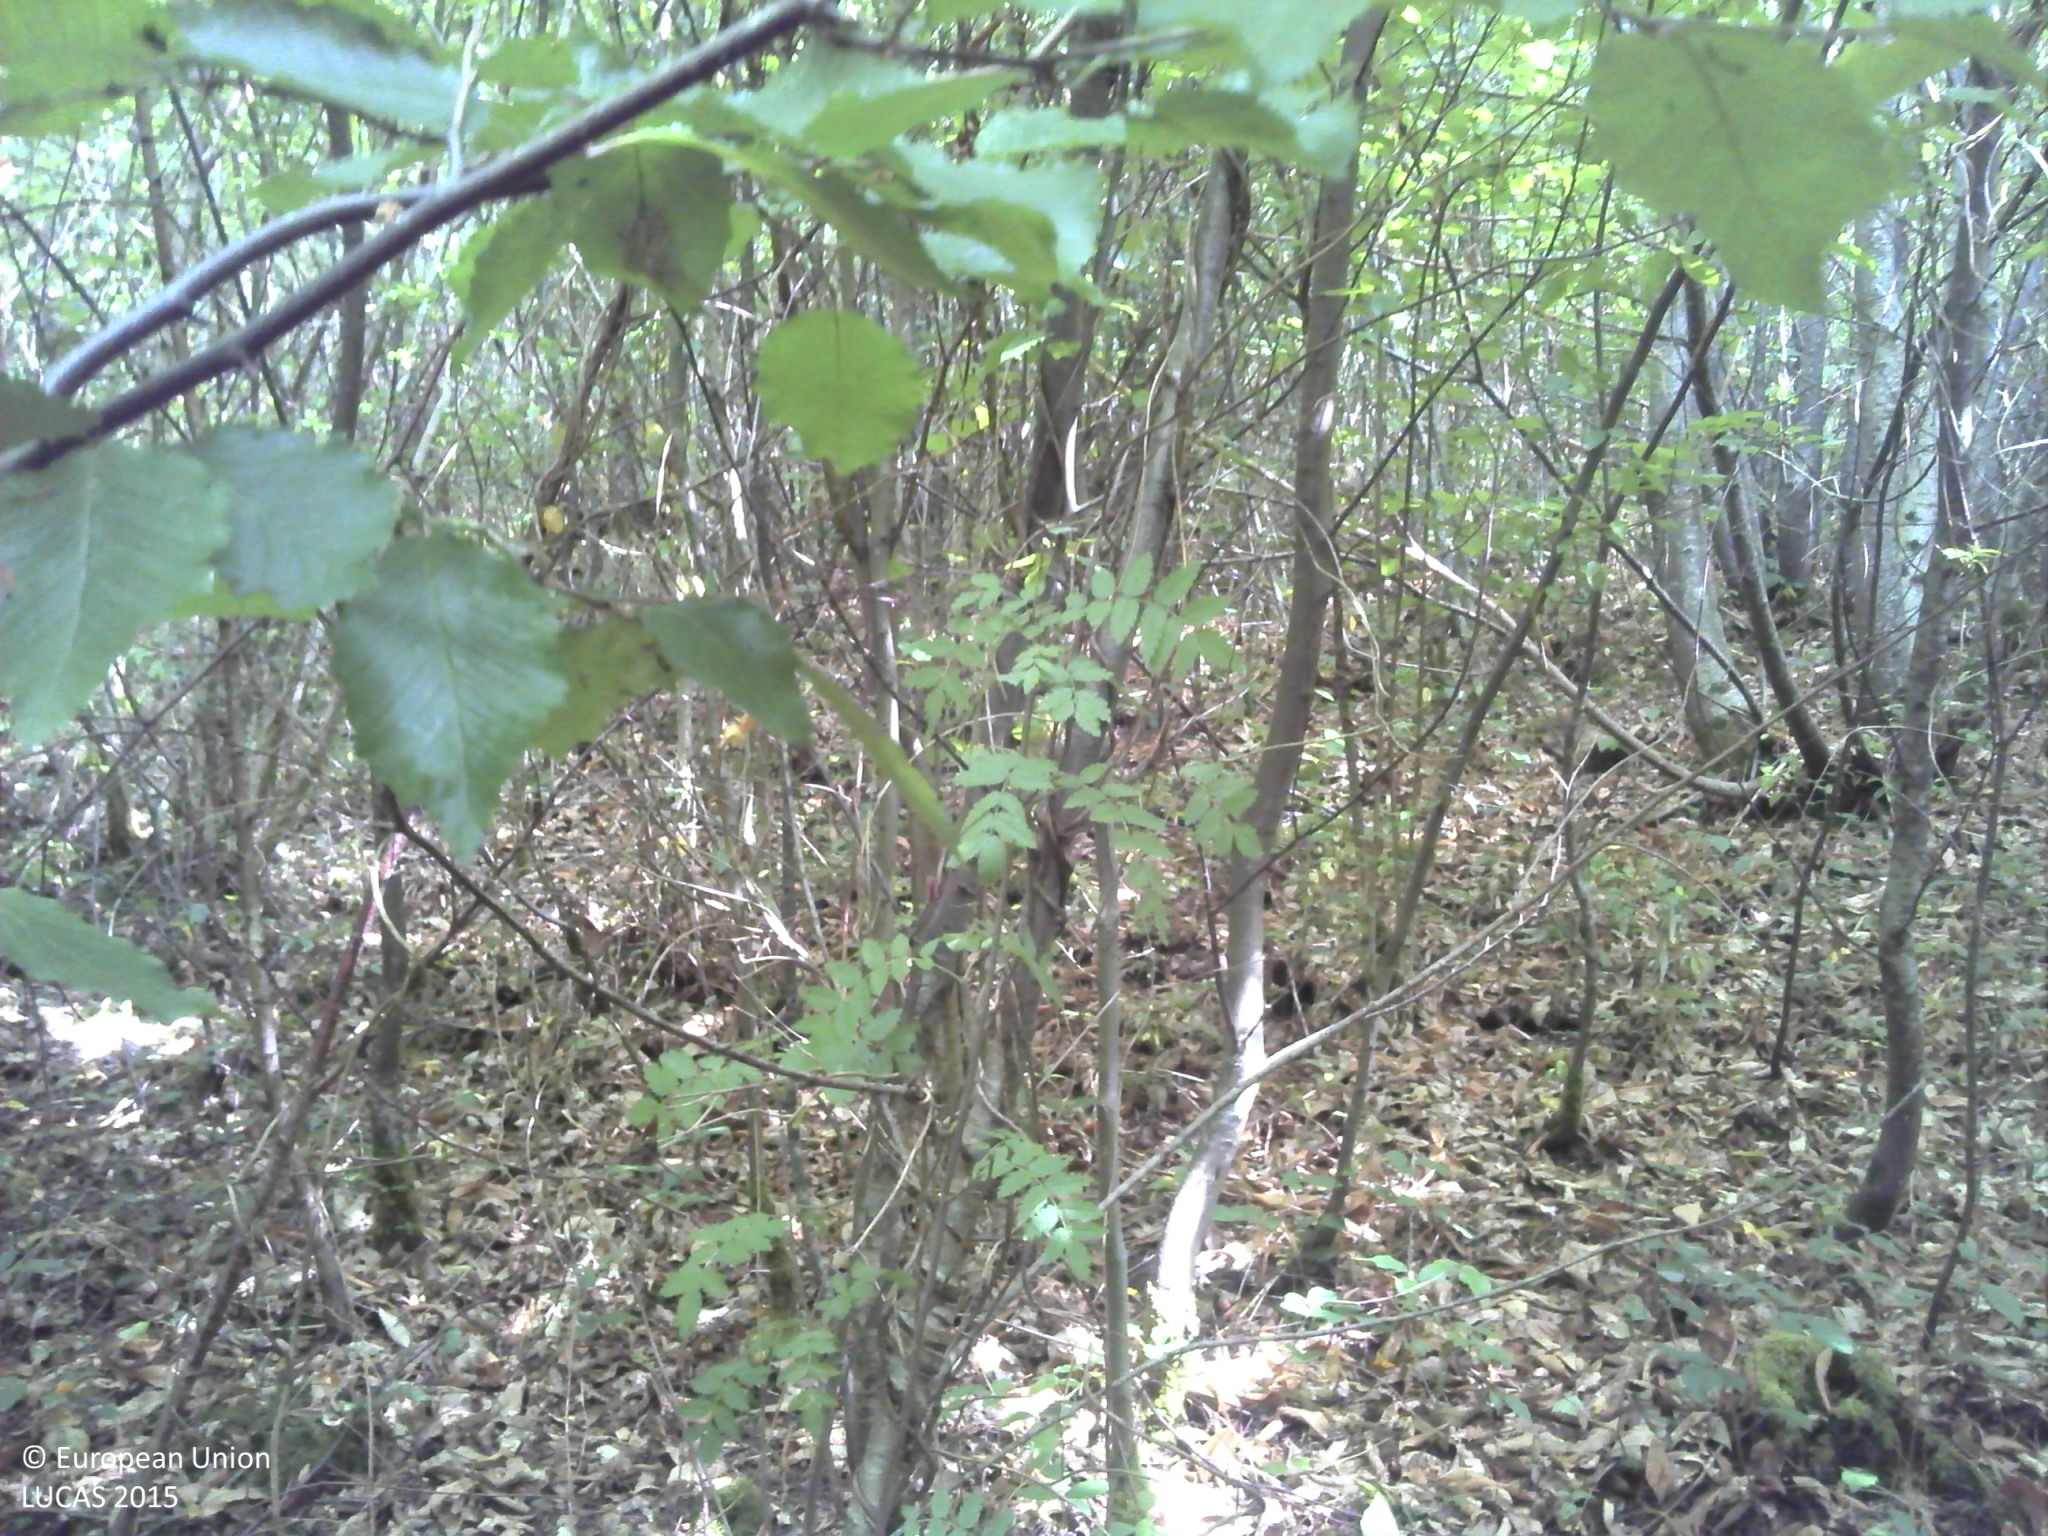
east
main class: Woodland
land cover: Broadleaved woodland
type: beech forest
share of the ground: > 75 %
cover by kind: broadleaved forest trees 70 %, herbaceous plants 20 %, consolidated bare surface 10 %
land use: Forestry
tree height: > 5 m
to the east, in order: Broadleaved woodland
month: July
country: FR
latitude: 49.3618
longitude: 4.7786
